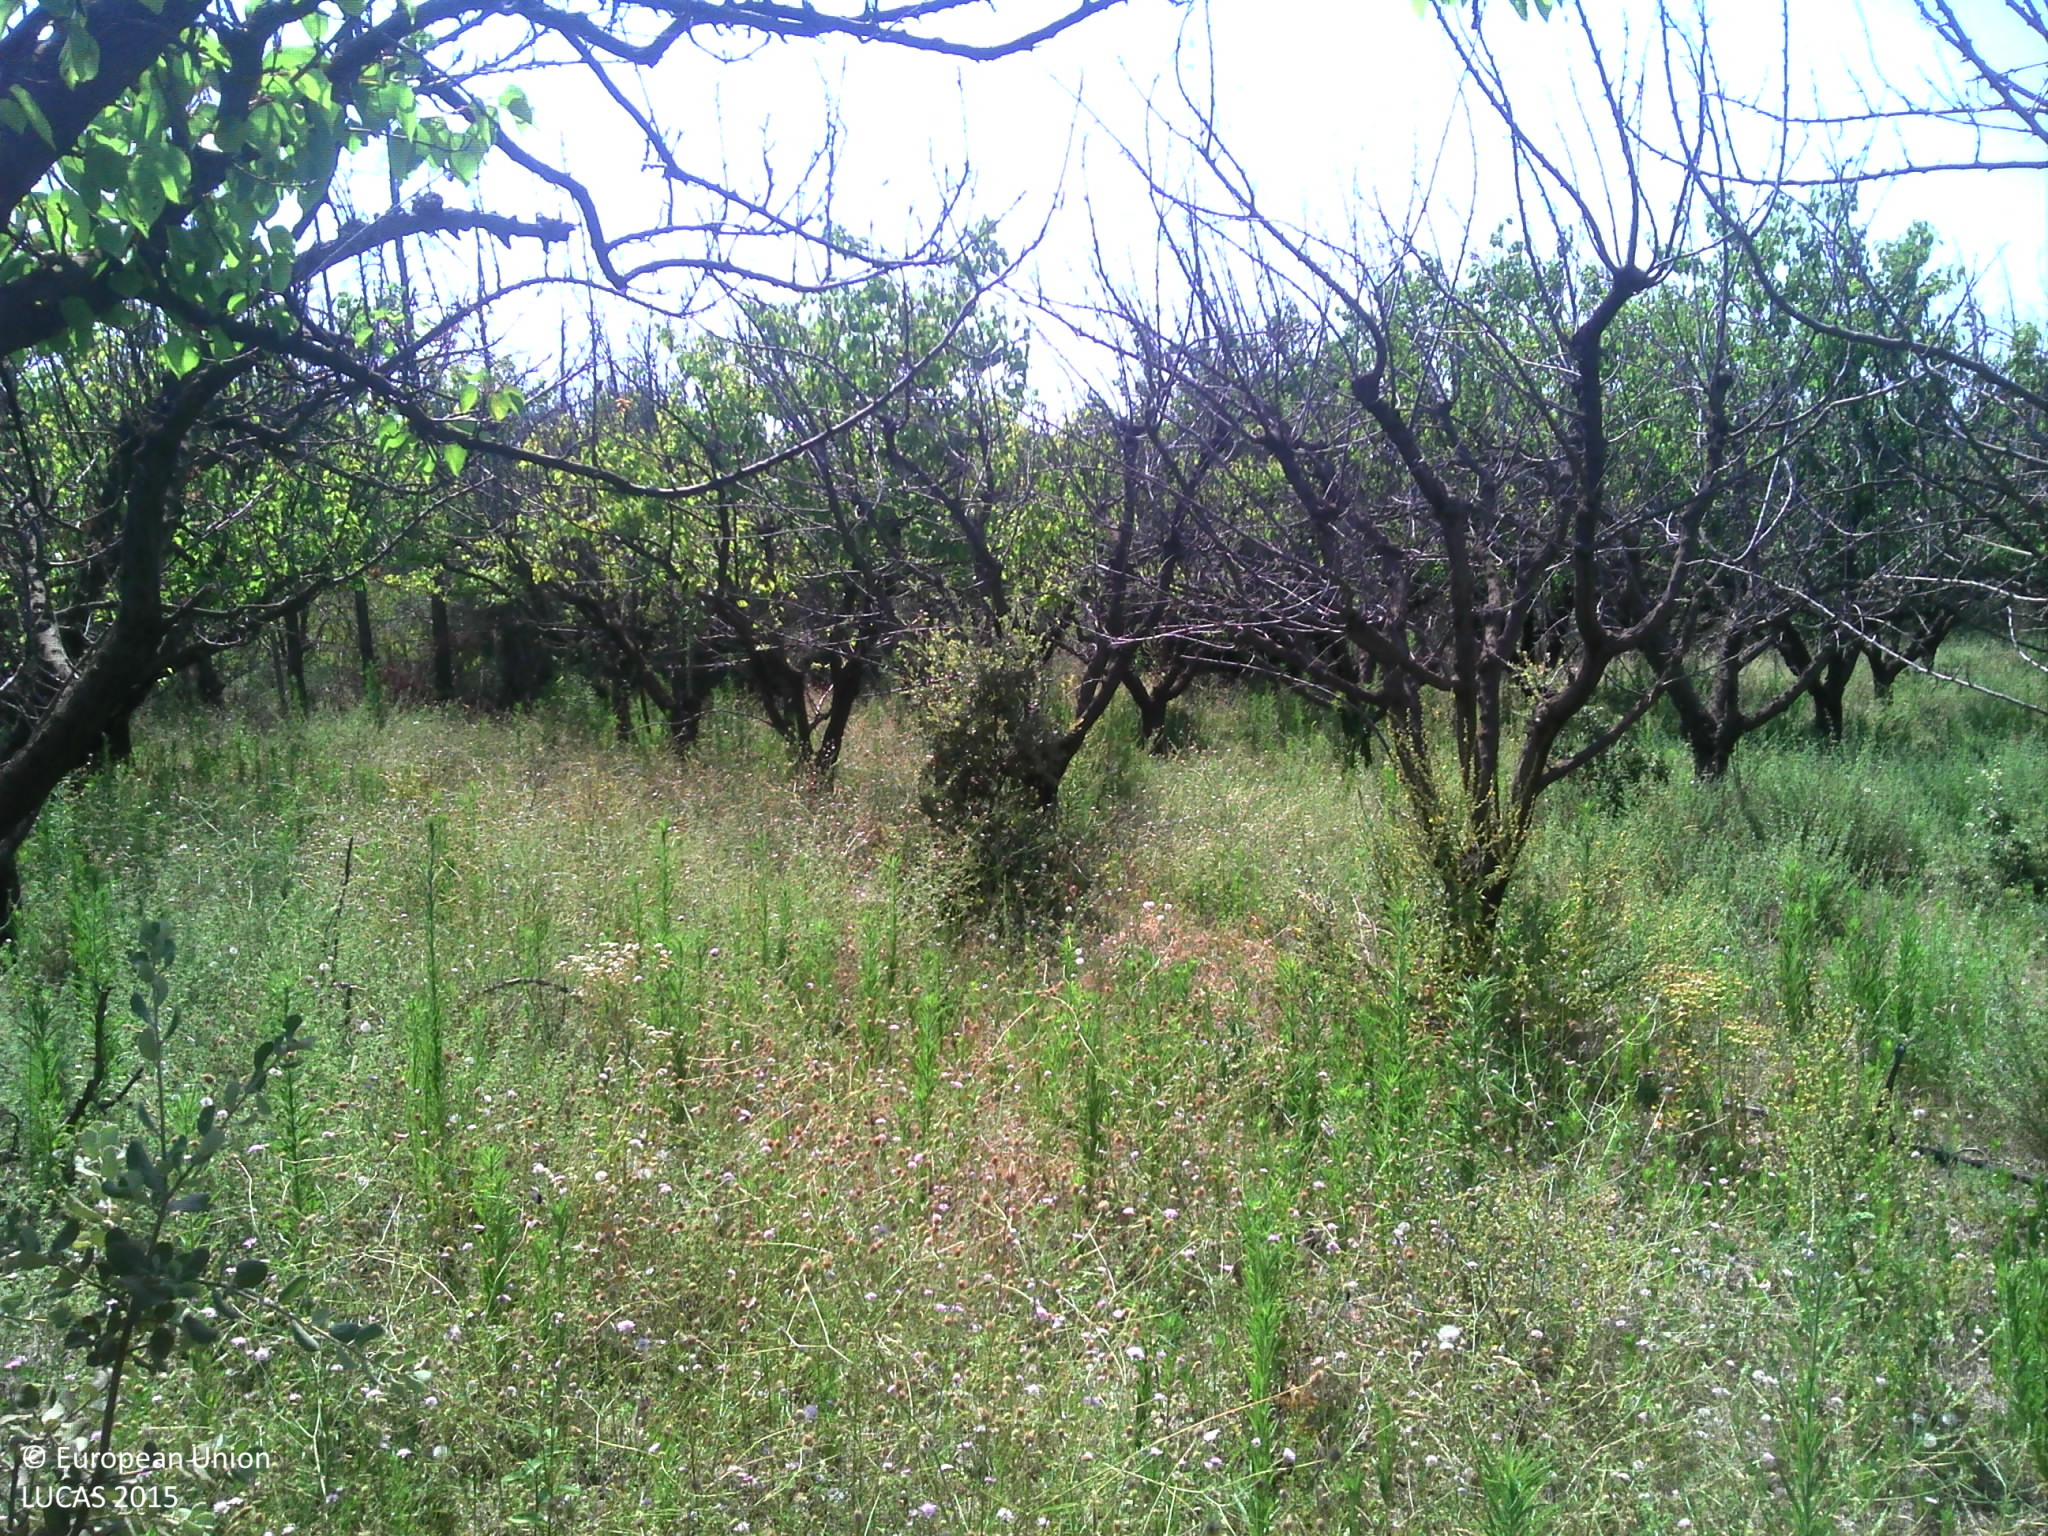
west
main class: Cropland
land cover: Other fruit trees and berries
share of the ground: 50 - 75 %
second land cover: Spontaneously vegetated surfaces
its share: 50 - 75 %
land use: Agriculture (excluding fallow land and kitchen gardens)
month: July
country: FR
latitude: 43.6751
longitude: 5.1101
